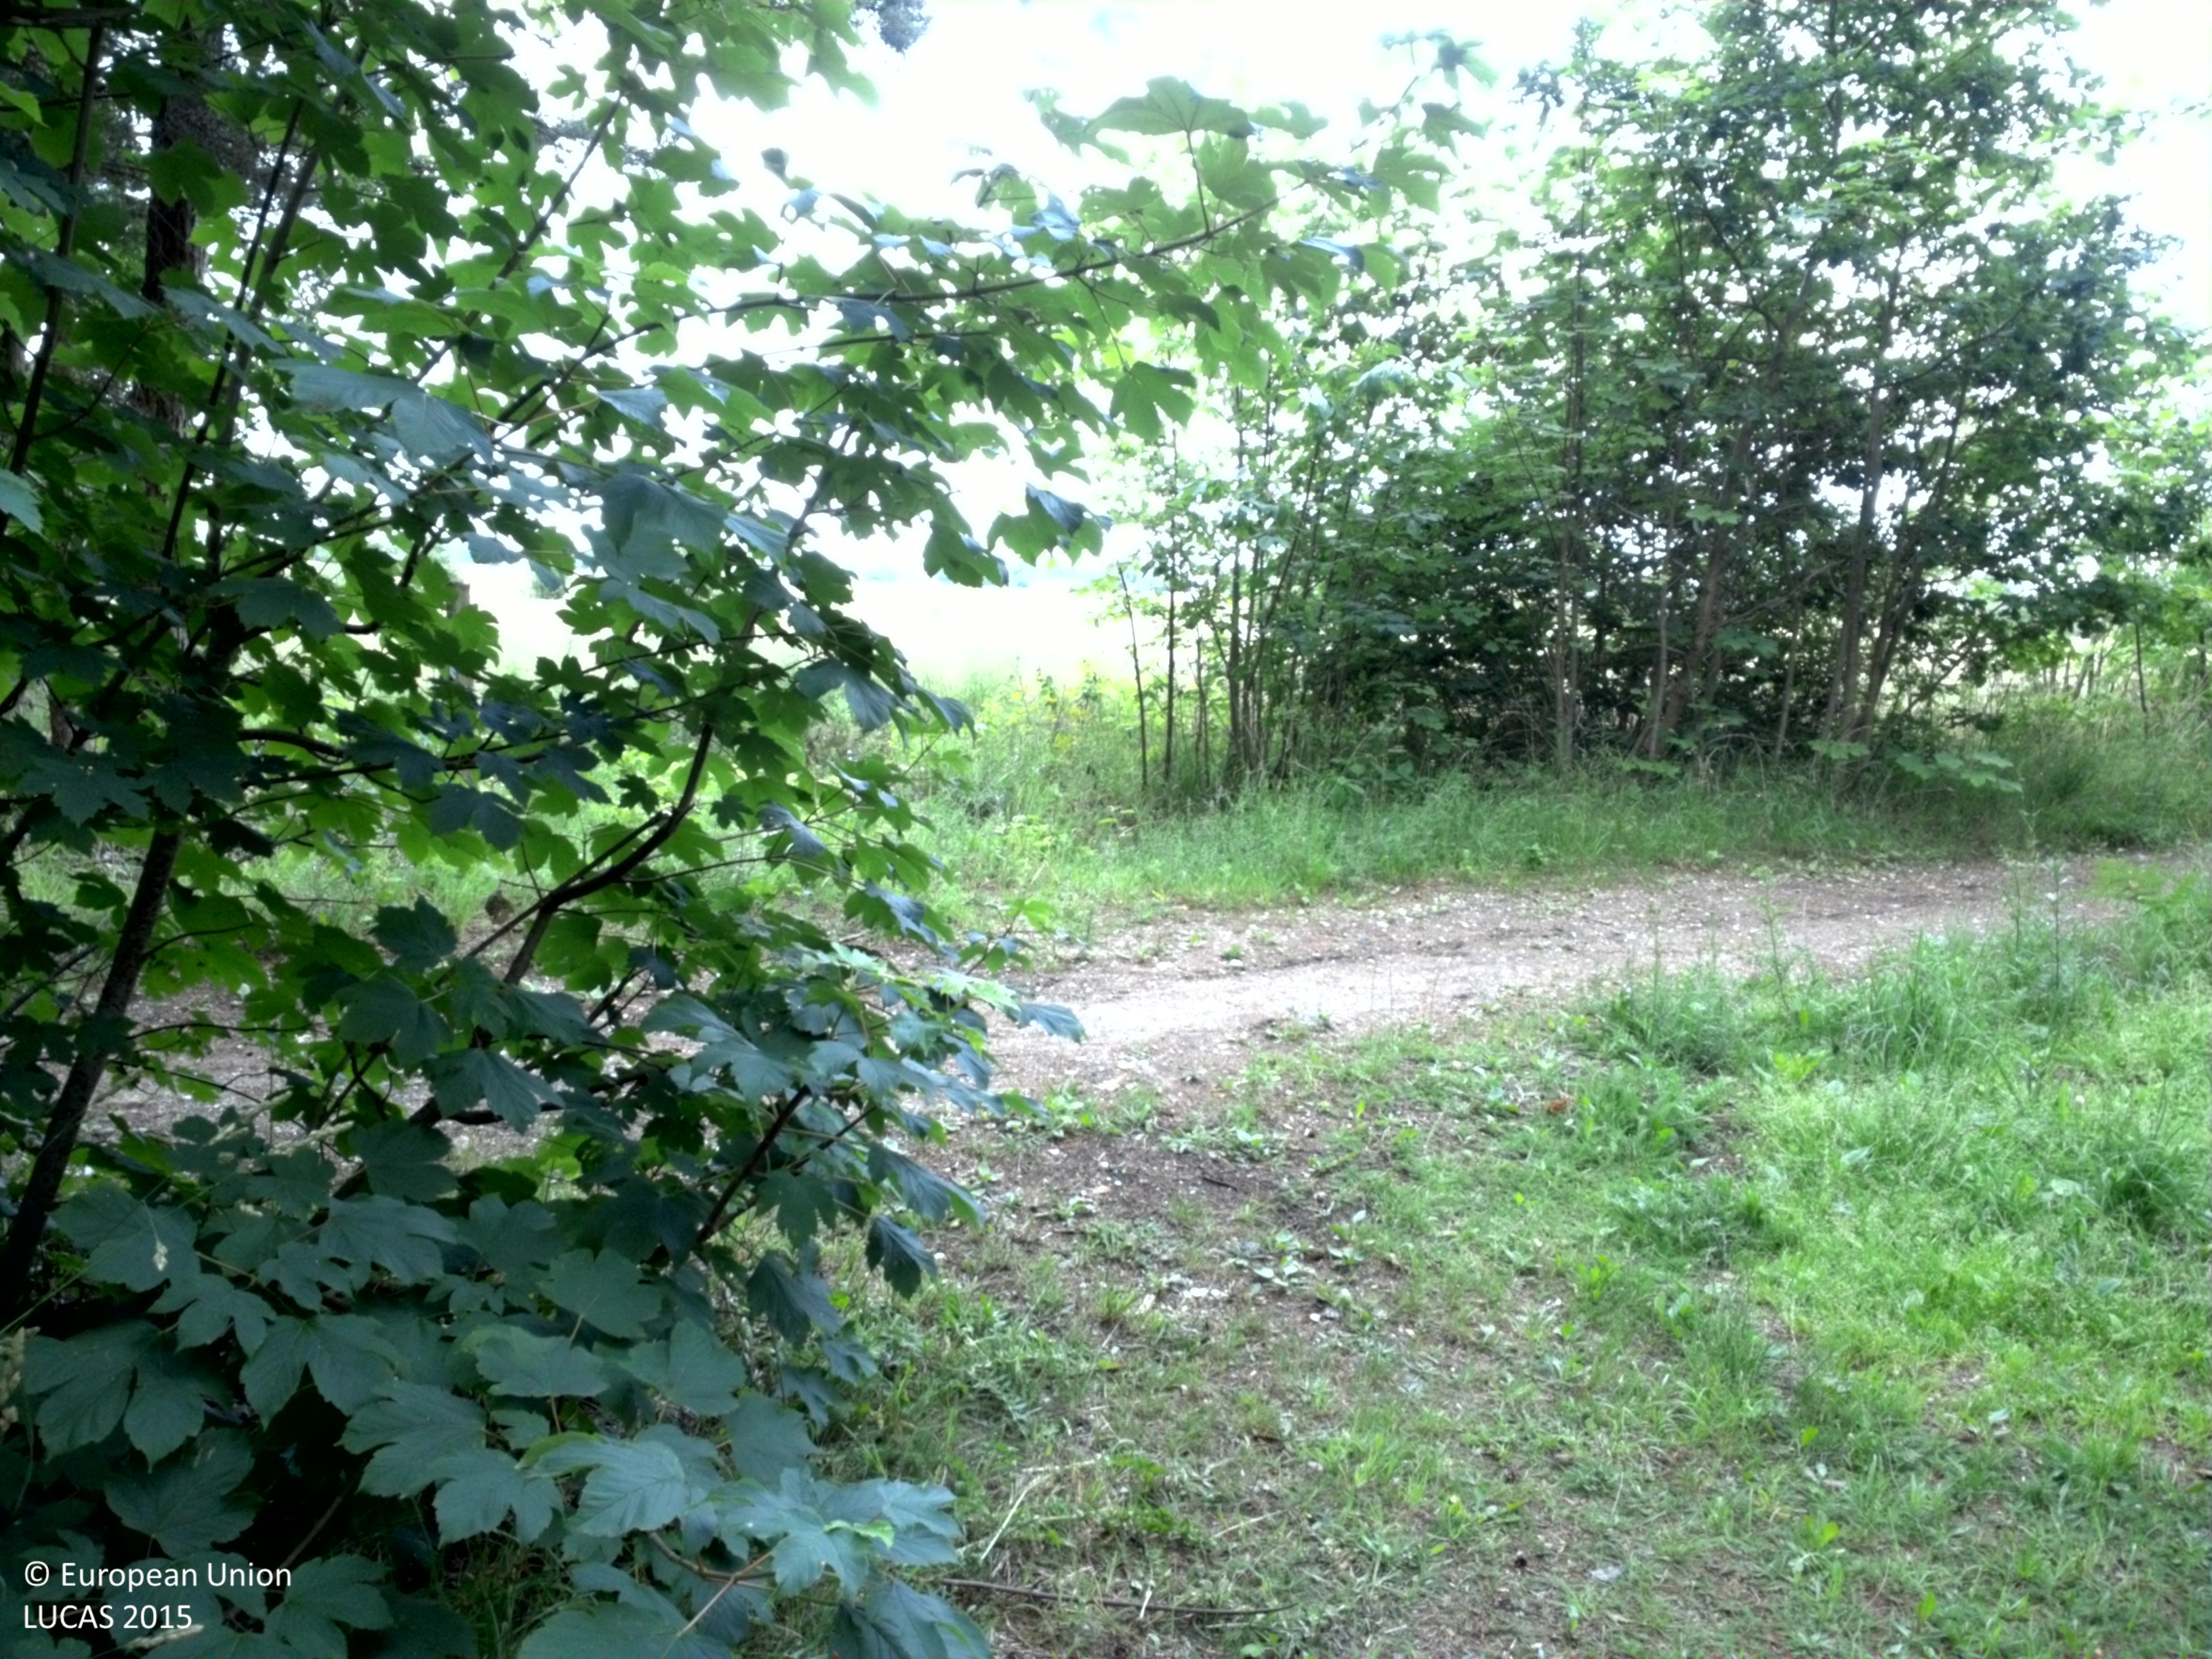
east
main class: Woodland
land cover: Pine dominated mixed woodland
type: hemiboreal forest and nemoral coniferous forest and mixed broadleaved-coniferous forest
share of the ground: > 75 %
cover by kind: coniferous forest trees 55 %, broadleaved forest trees 20 %, herbaceous plants 15 %, shrubs 10 %
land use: Forestry
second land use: Amenities, museums, leisure
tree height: > 5 m
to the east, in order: Pine dominated mixed woodland; Tracks; Fences; Pine dominated mixed woodland; Common wheat; Ditches and canals; Abandoned hedges; Common wheat
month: July
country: SE
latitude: 57.4440
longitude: 18.4896
